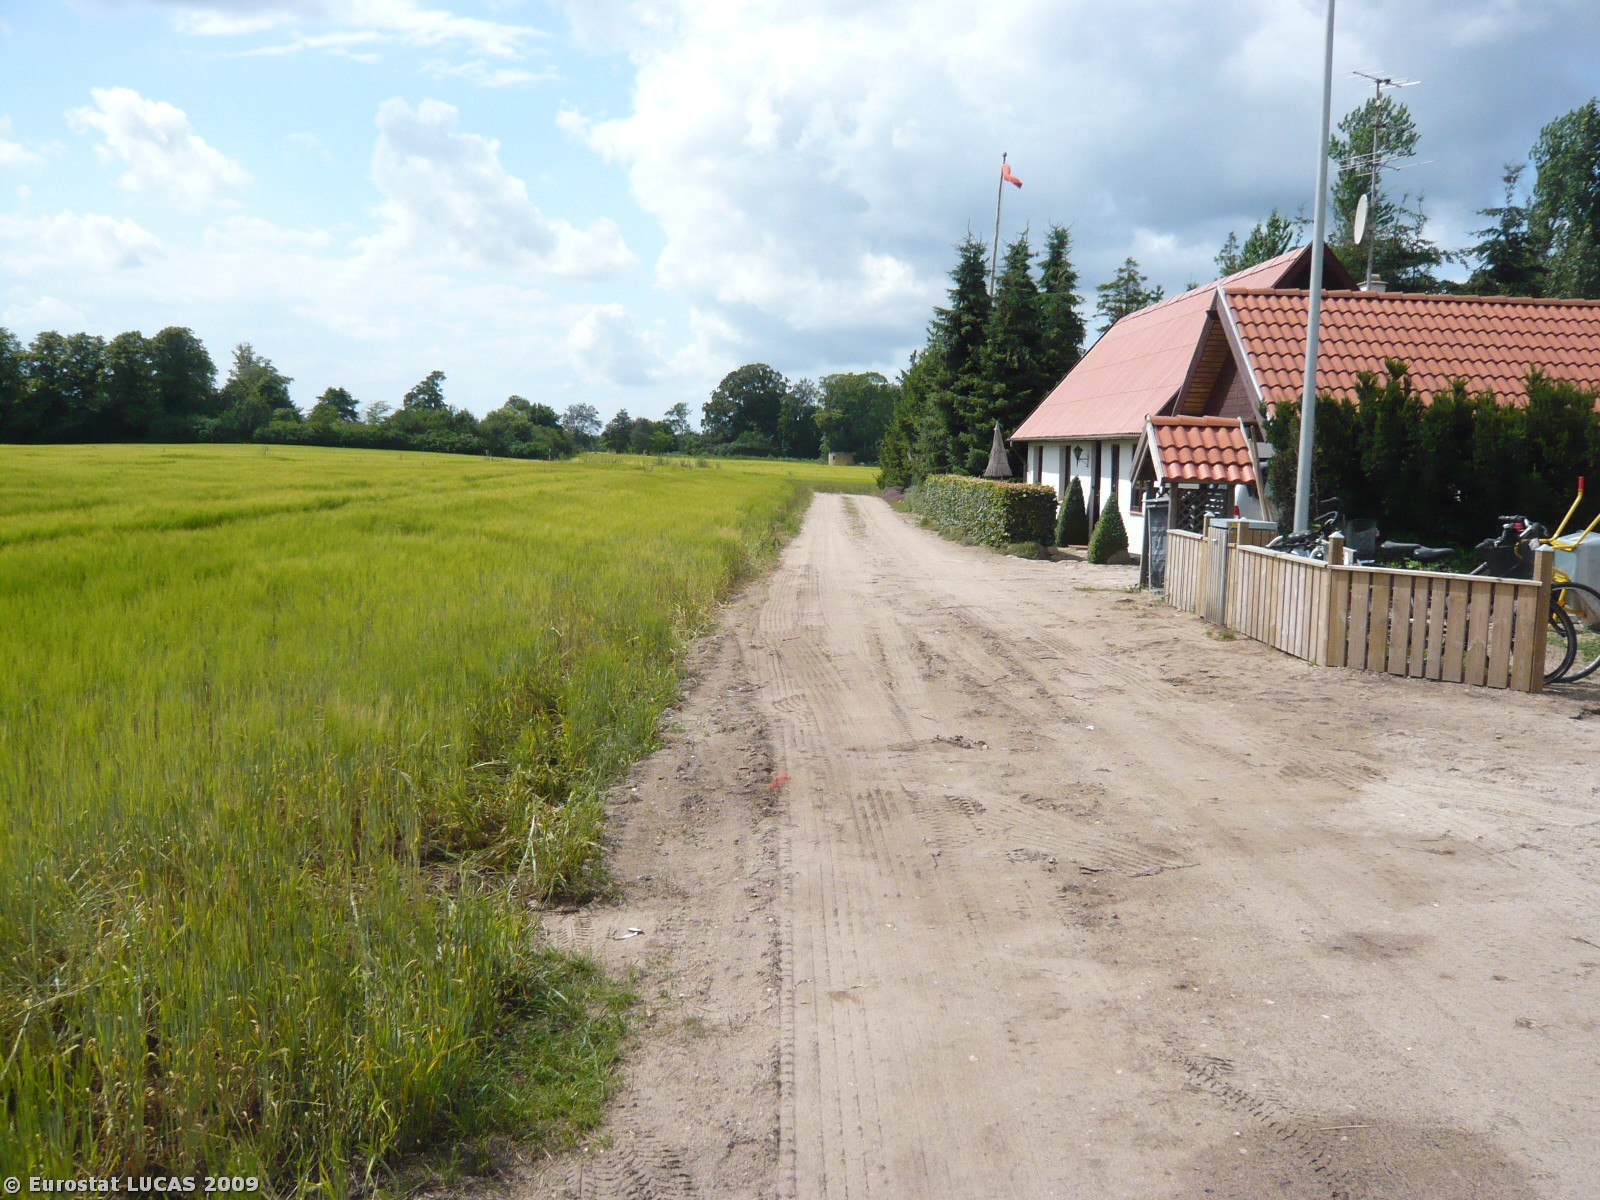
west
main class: Cropland
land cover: Barley
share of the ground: > 75 %
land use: Agriculture (excluding fallow land and kitchen gardens)
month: July
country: DK
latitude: 55.5677
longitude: 11.5051
